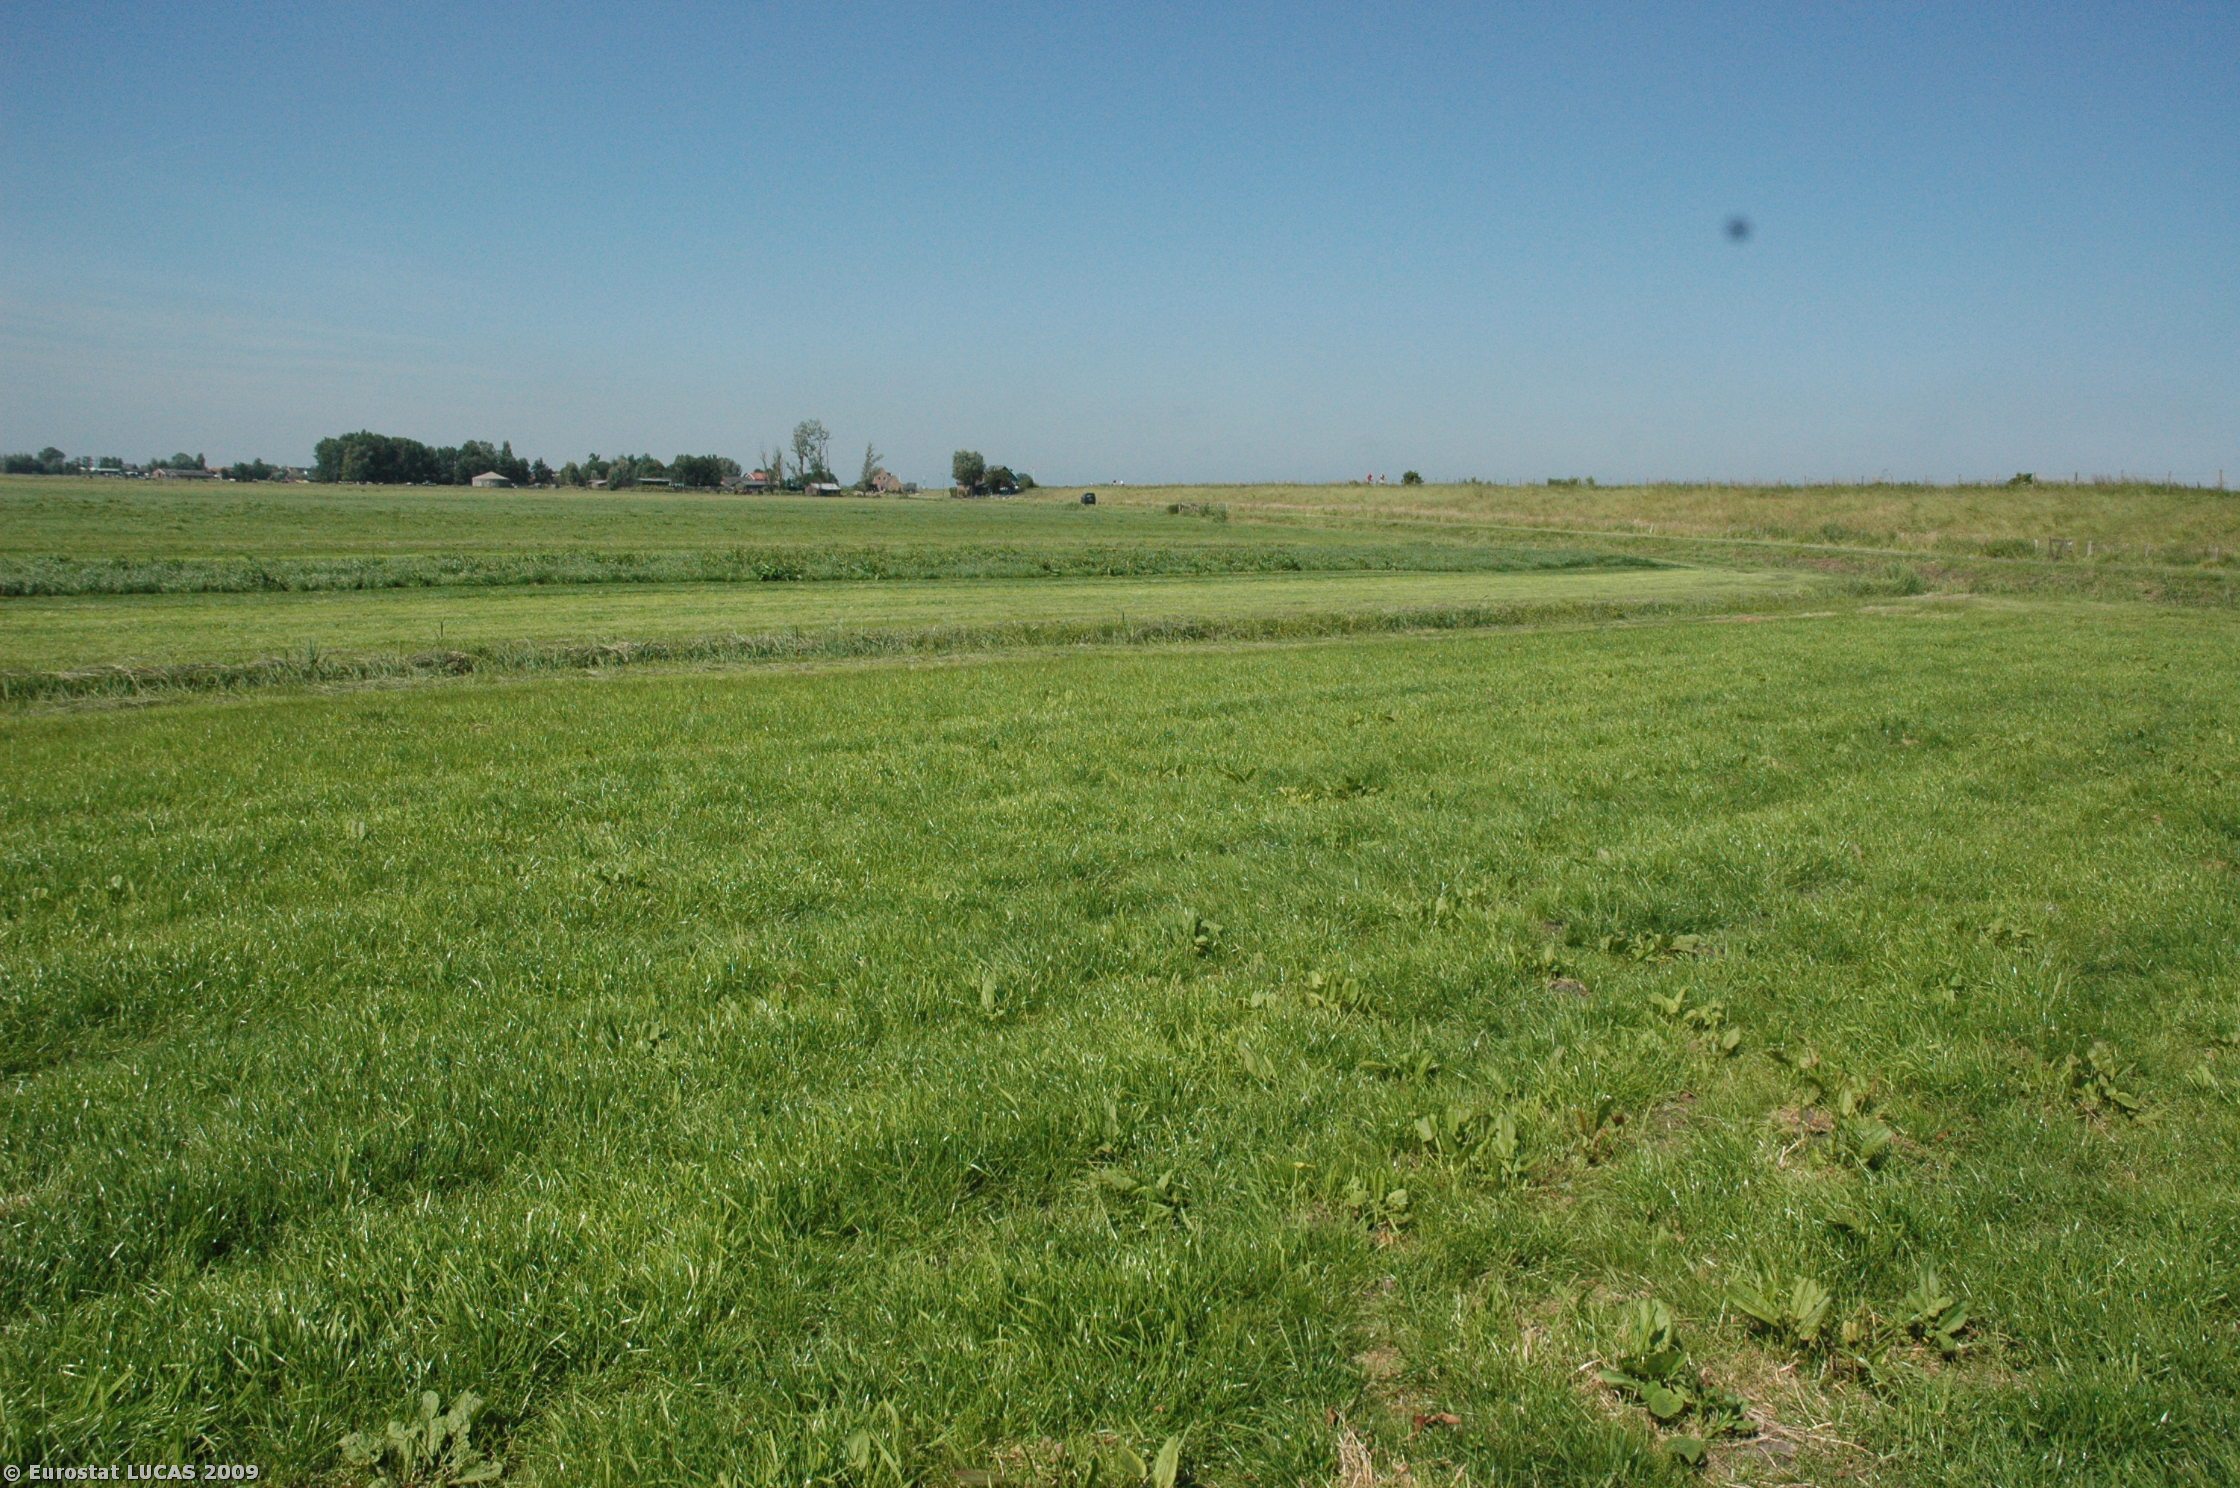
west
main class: Grassland
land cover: Grassland without tree/shrub cover
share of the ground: > 75 %
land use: Agriculture (excluding fallow land and kitchen gardens)
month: June
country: NL
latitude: 52.2685
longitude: 5.3528
